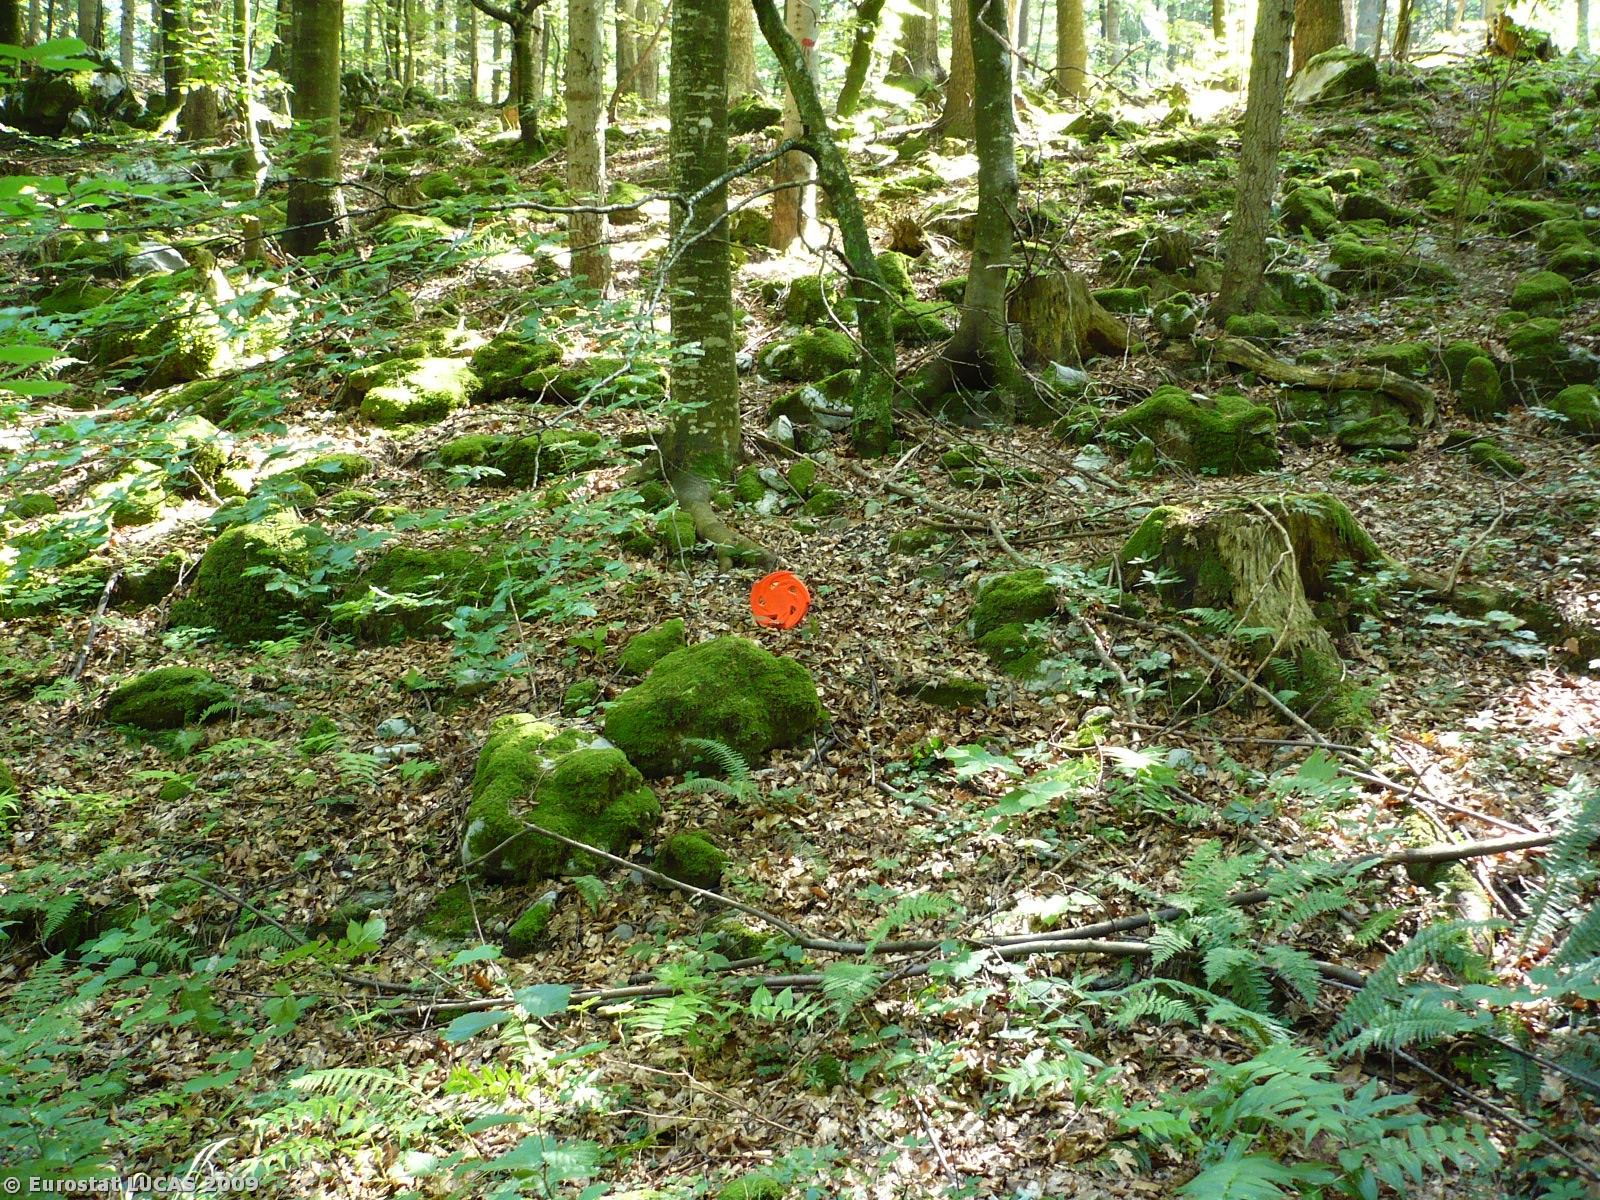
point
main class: Woodland
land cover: Mixed woodland
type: mountainous beech forest
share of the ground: > 75 %
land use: Forestry
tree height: > 5 m
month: July
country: SI
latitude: 45.7225
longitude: 14.3257
